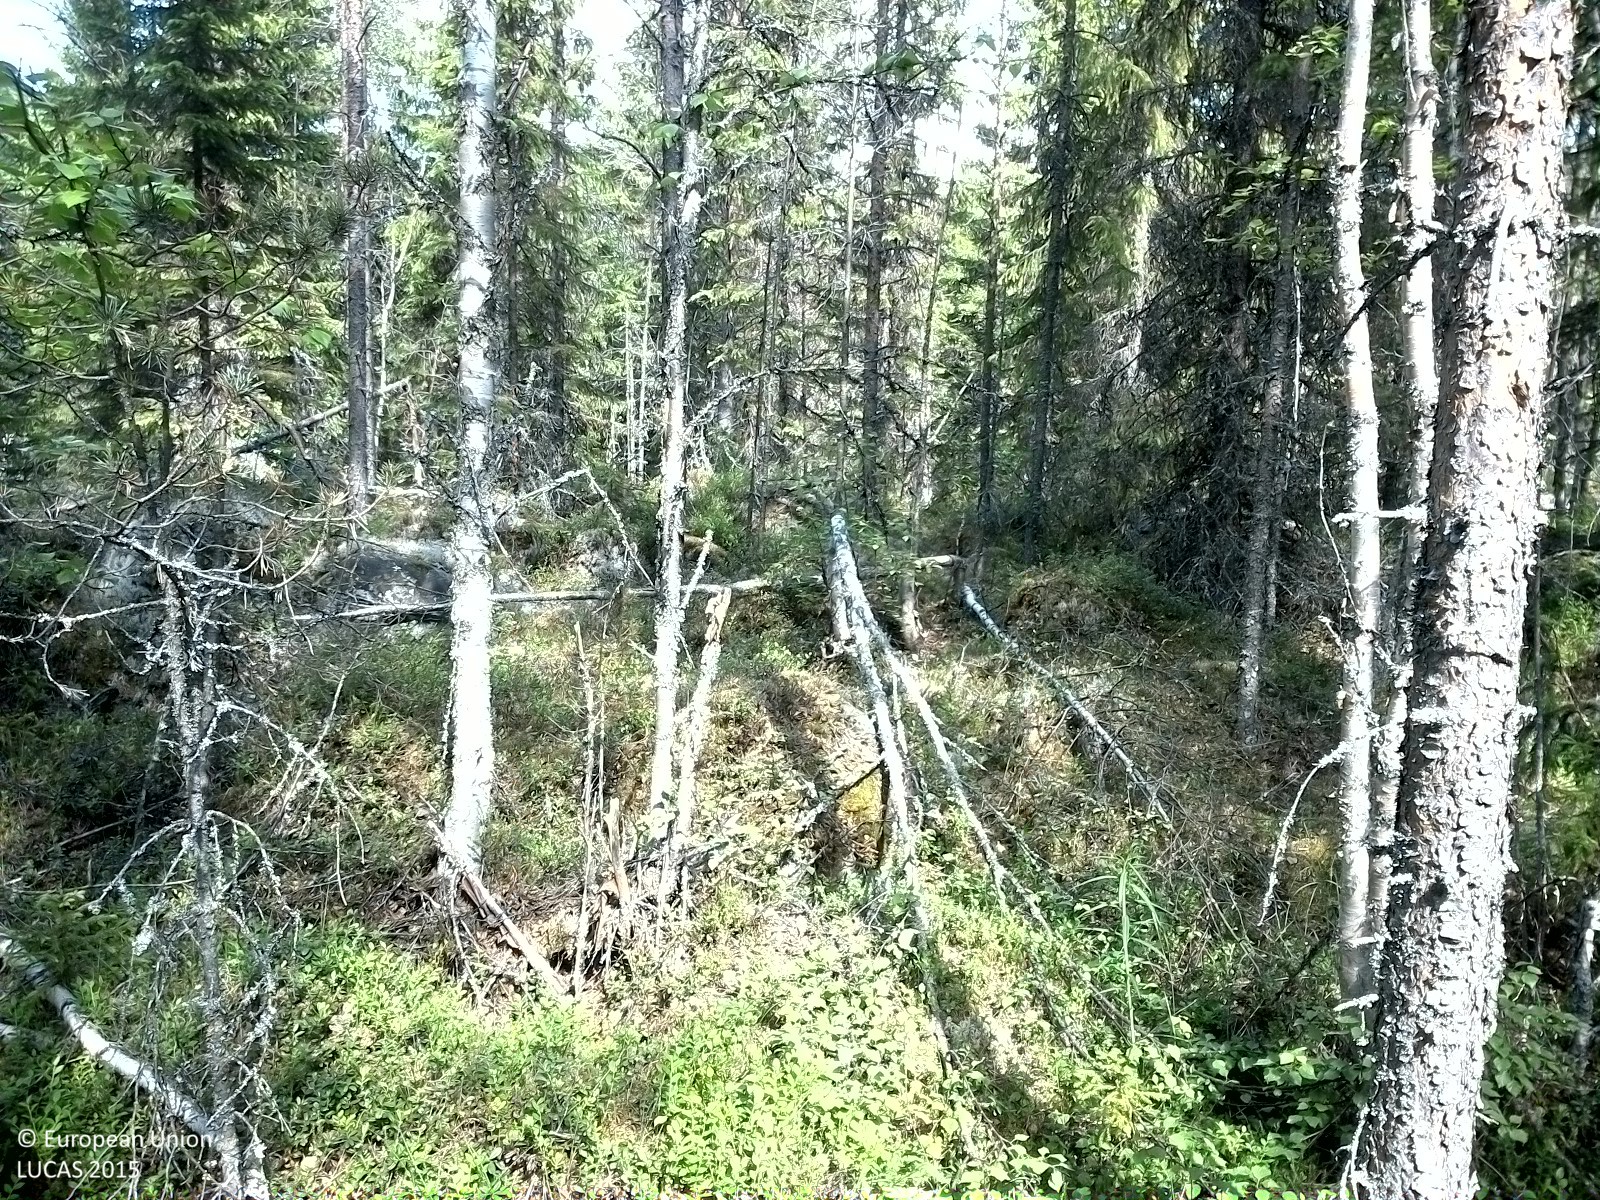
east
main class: Woodland
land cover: Other mixed woodland
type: boreal forest
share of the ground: 25 - 50 %
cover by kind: broadleaved forest trees 30 %, shrubs 30 %, coniferous forest trees 20 %, lichens and mosses 20 %
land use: Forestry
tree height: > 5 m
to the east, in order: Other mixed woodland; Spruce dominated coniferous woodland; Broadleaved woodland; Inland fresh running water; Pine dominated mixed woodland; Grass margins; Paved roads, cycling and walking lanes; Ditches and canals; Other mixed woodland; Spruce dominated mixed woodland
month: June
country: SE
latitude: 62.1682
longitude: 16.4127
